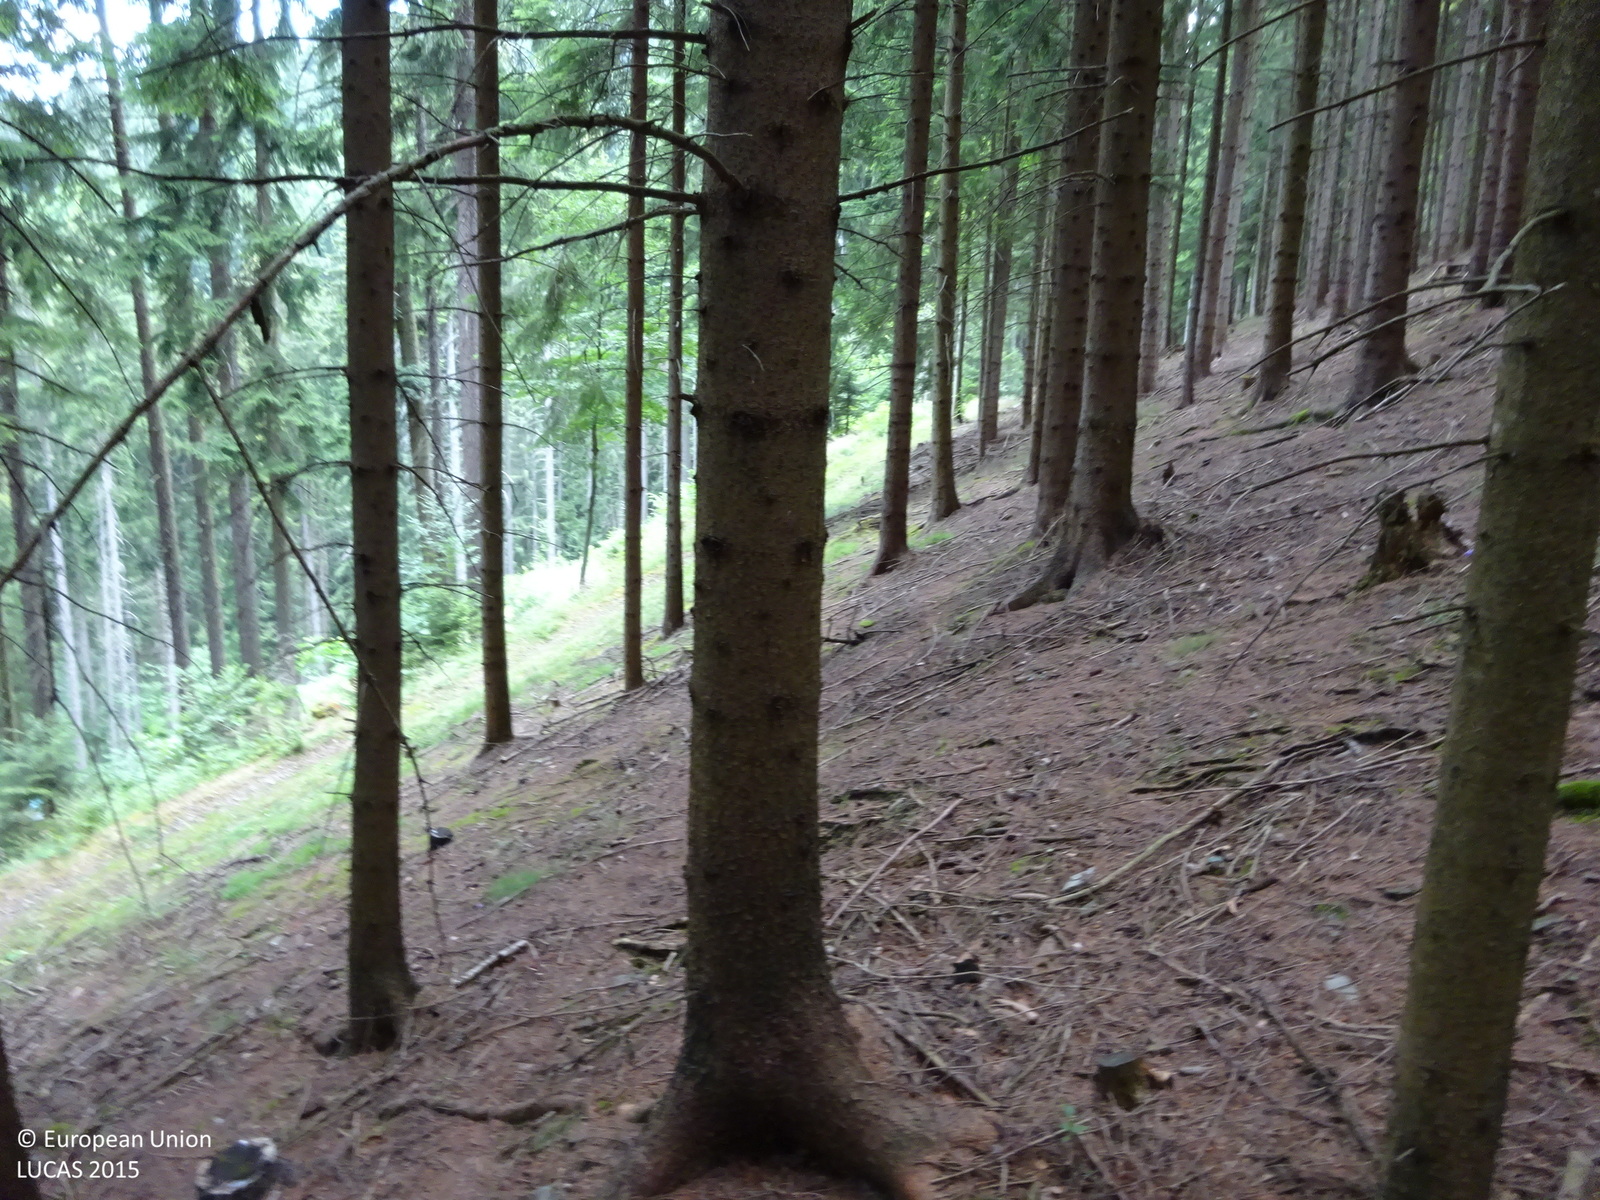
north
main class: Woodland
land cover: Spruce dominated coniferous woodland
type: alpine coniferous forest
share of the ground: > 75 %
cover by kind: coniferous forest trees 100 %
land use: Forestry
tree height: > 5 m
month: July
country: AT
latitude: 47.1881
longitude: 15.4242
